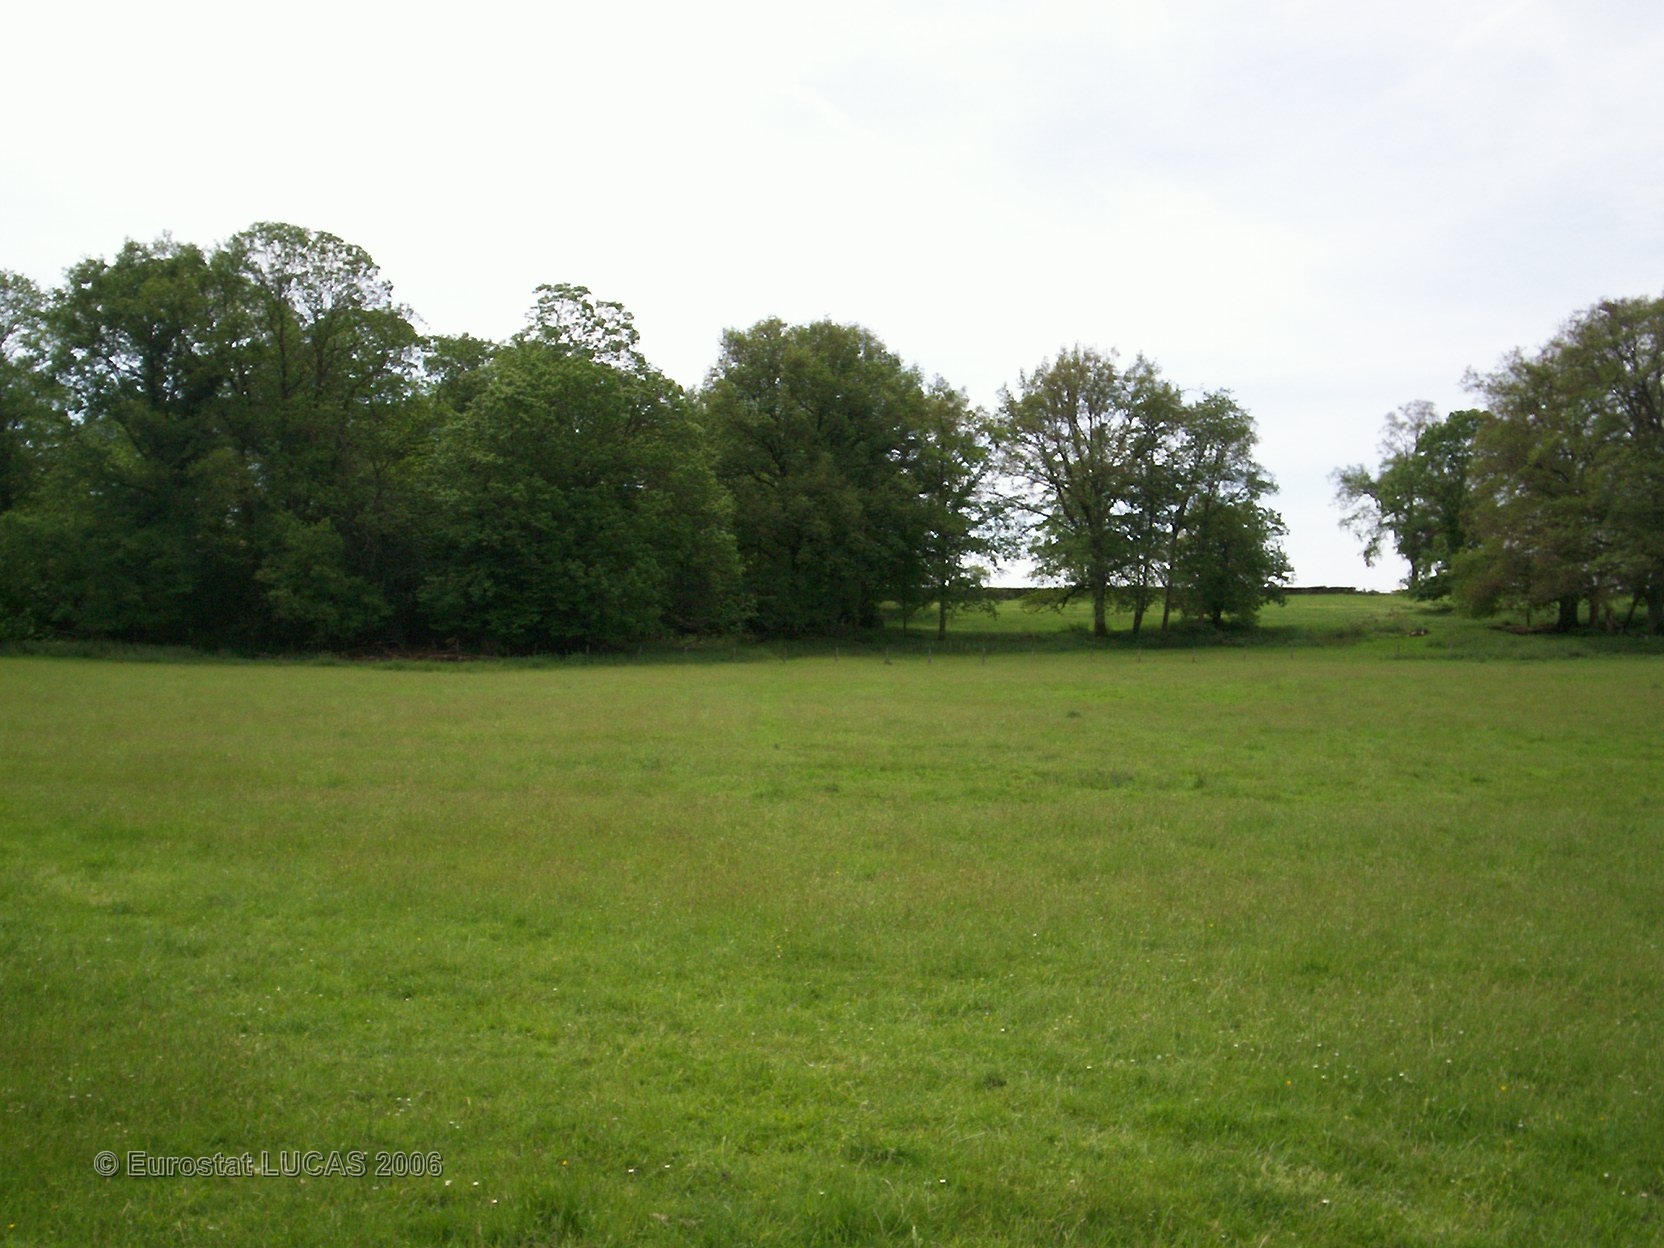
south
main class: Grassland
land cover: Grassland without tree/shrub cover
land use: Agriculture (excluding fallow land and kitchen gardens)
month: May
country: FR
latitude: 46.1622
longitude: 1.1176
